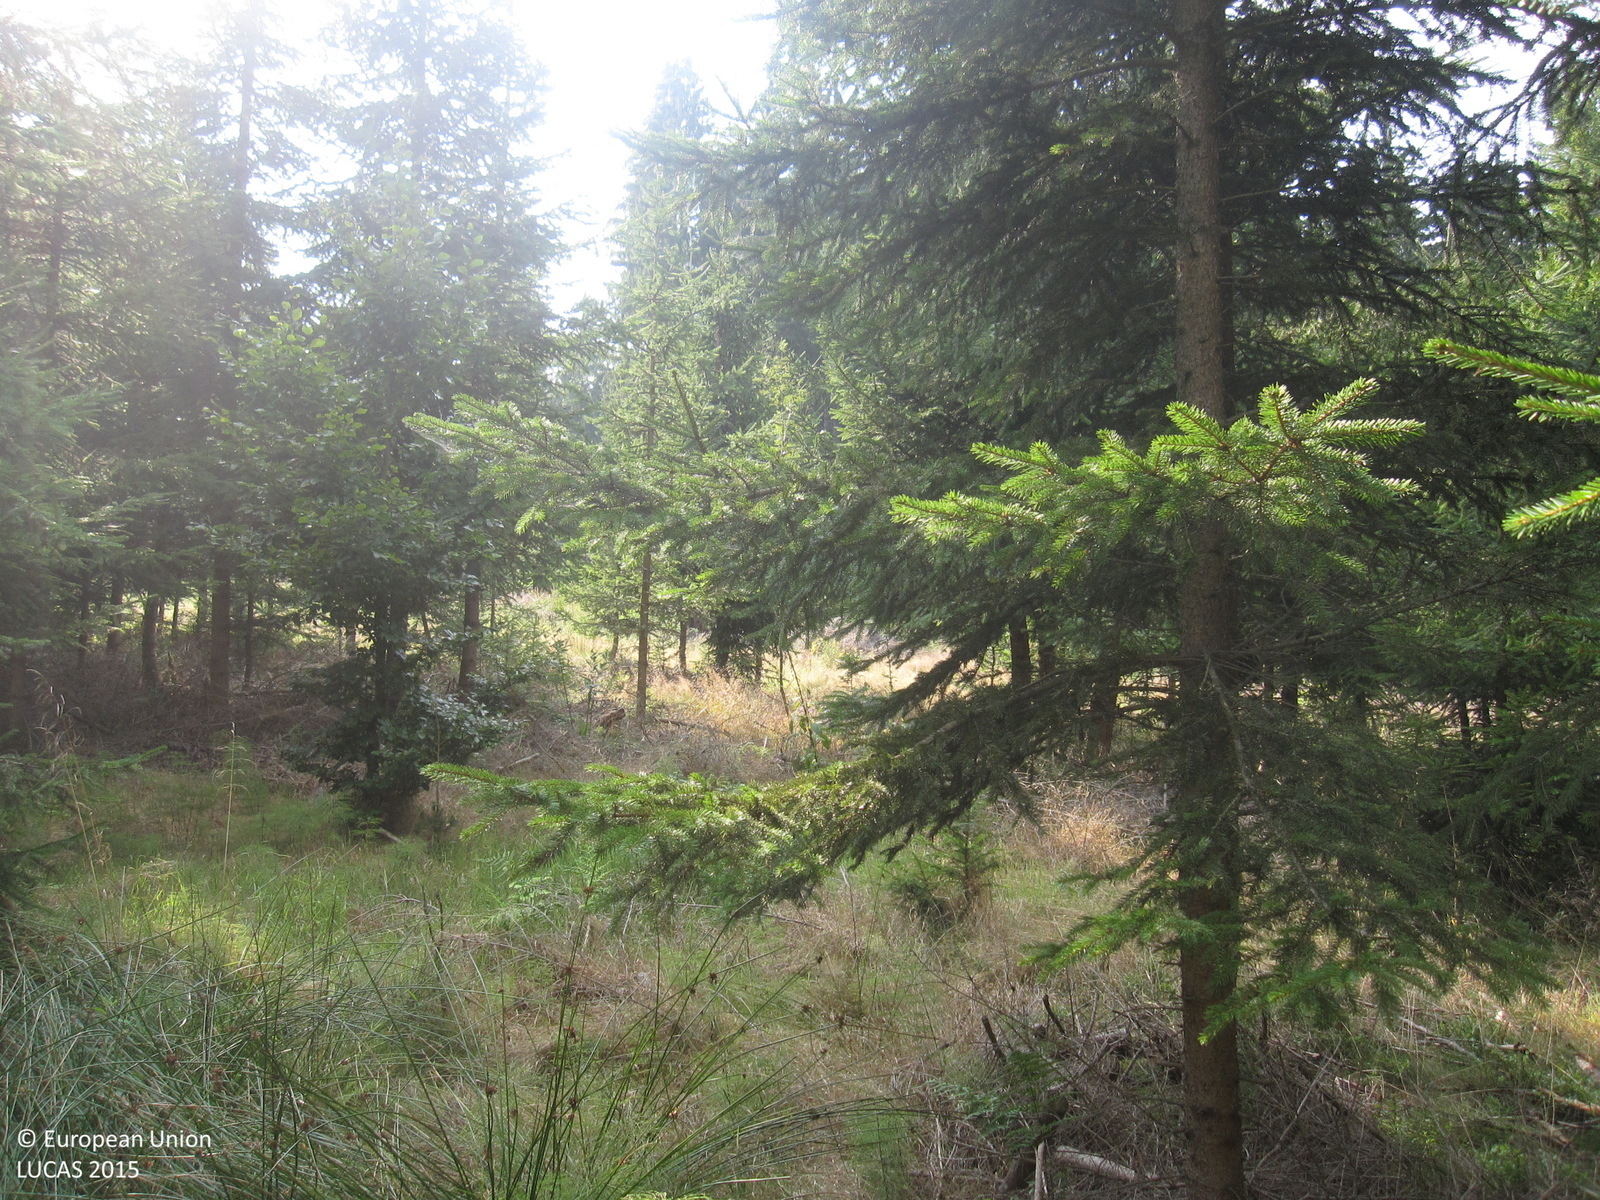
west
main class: Woodland
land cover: Spruce dominated coniferous woodland
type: hemiboreal forest and nemoral coniferous forest and mixed broadleaved-coniferous forest
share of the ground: > 75 %
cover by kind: coniferous forest trees 95 %, unconsolidated bare surface 5 %
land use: Forestry
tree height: > 5 m
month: August
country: DE
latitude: 50.4257
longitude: 11.5339
